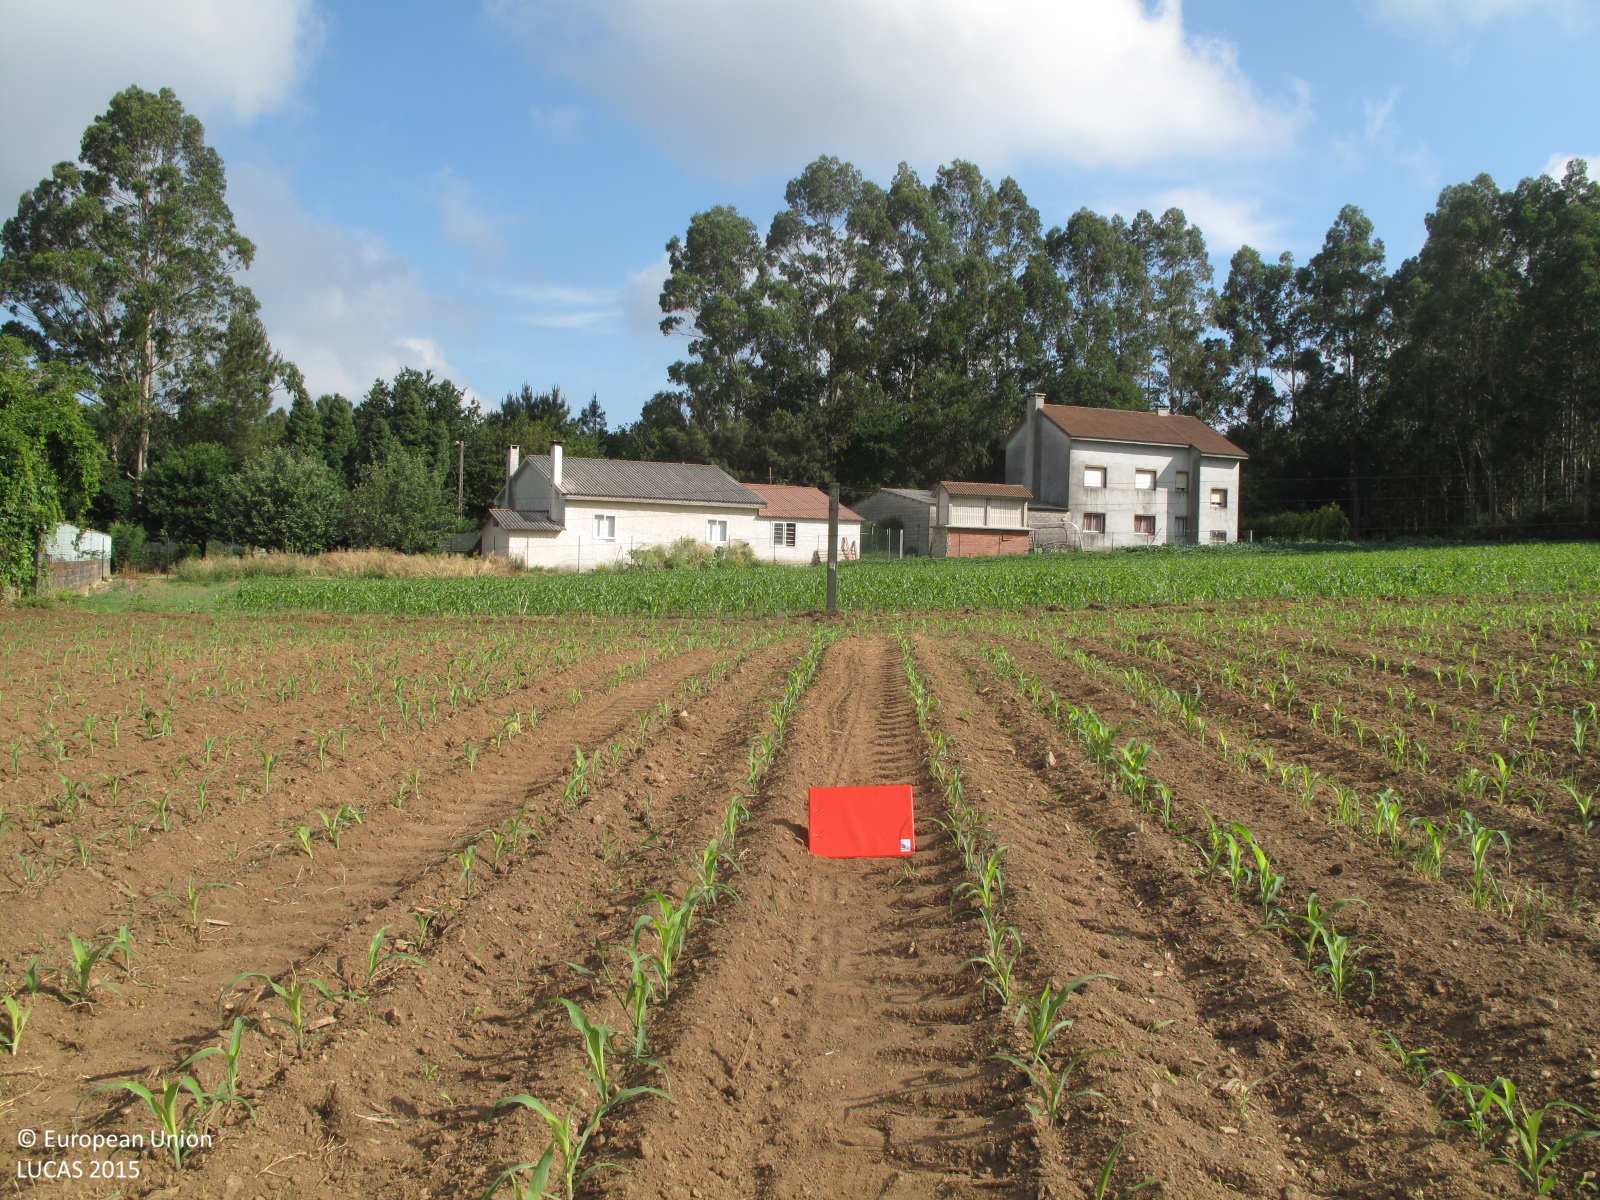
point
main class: Cropland
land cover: Maize
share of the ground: < 10 %
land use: Agriculture (excluding fallow land and kitchen gardens)
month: June
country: ES
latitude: 42.9025
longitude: -8.4361
